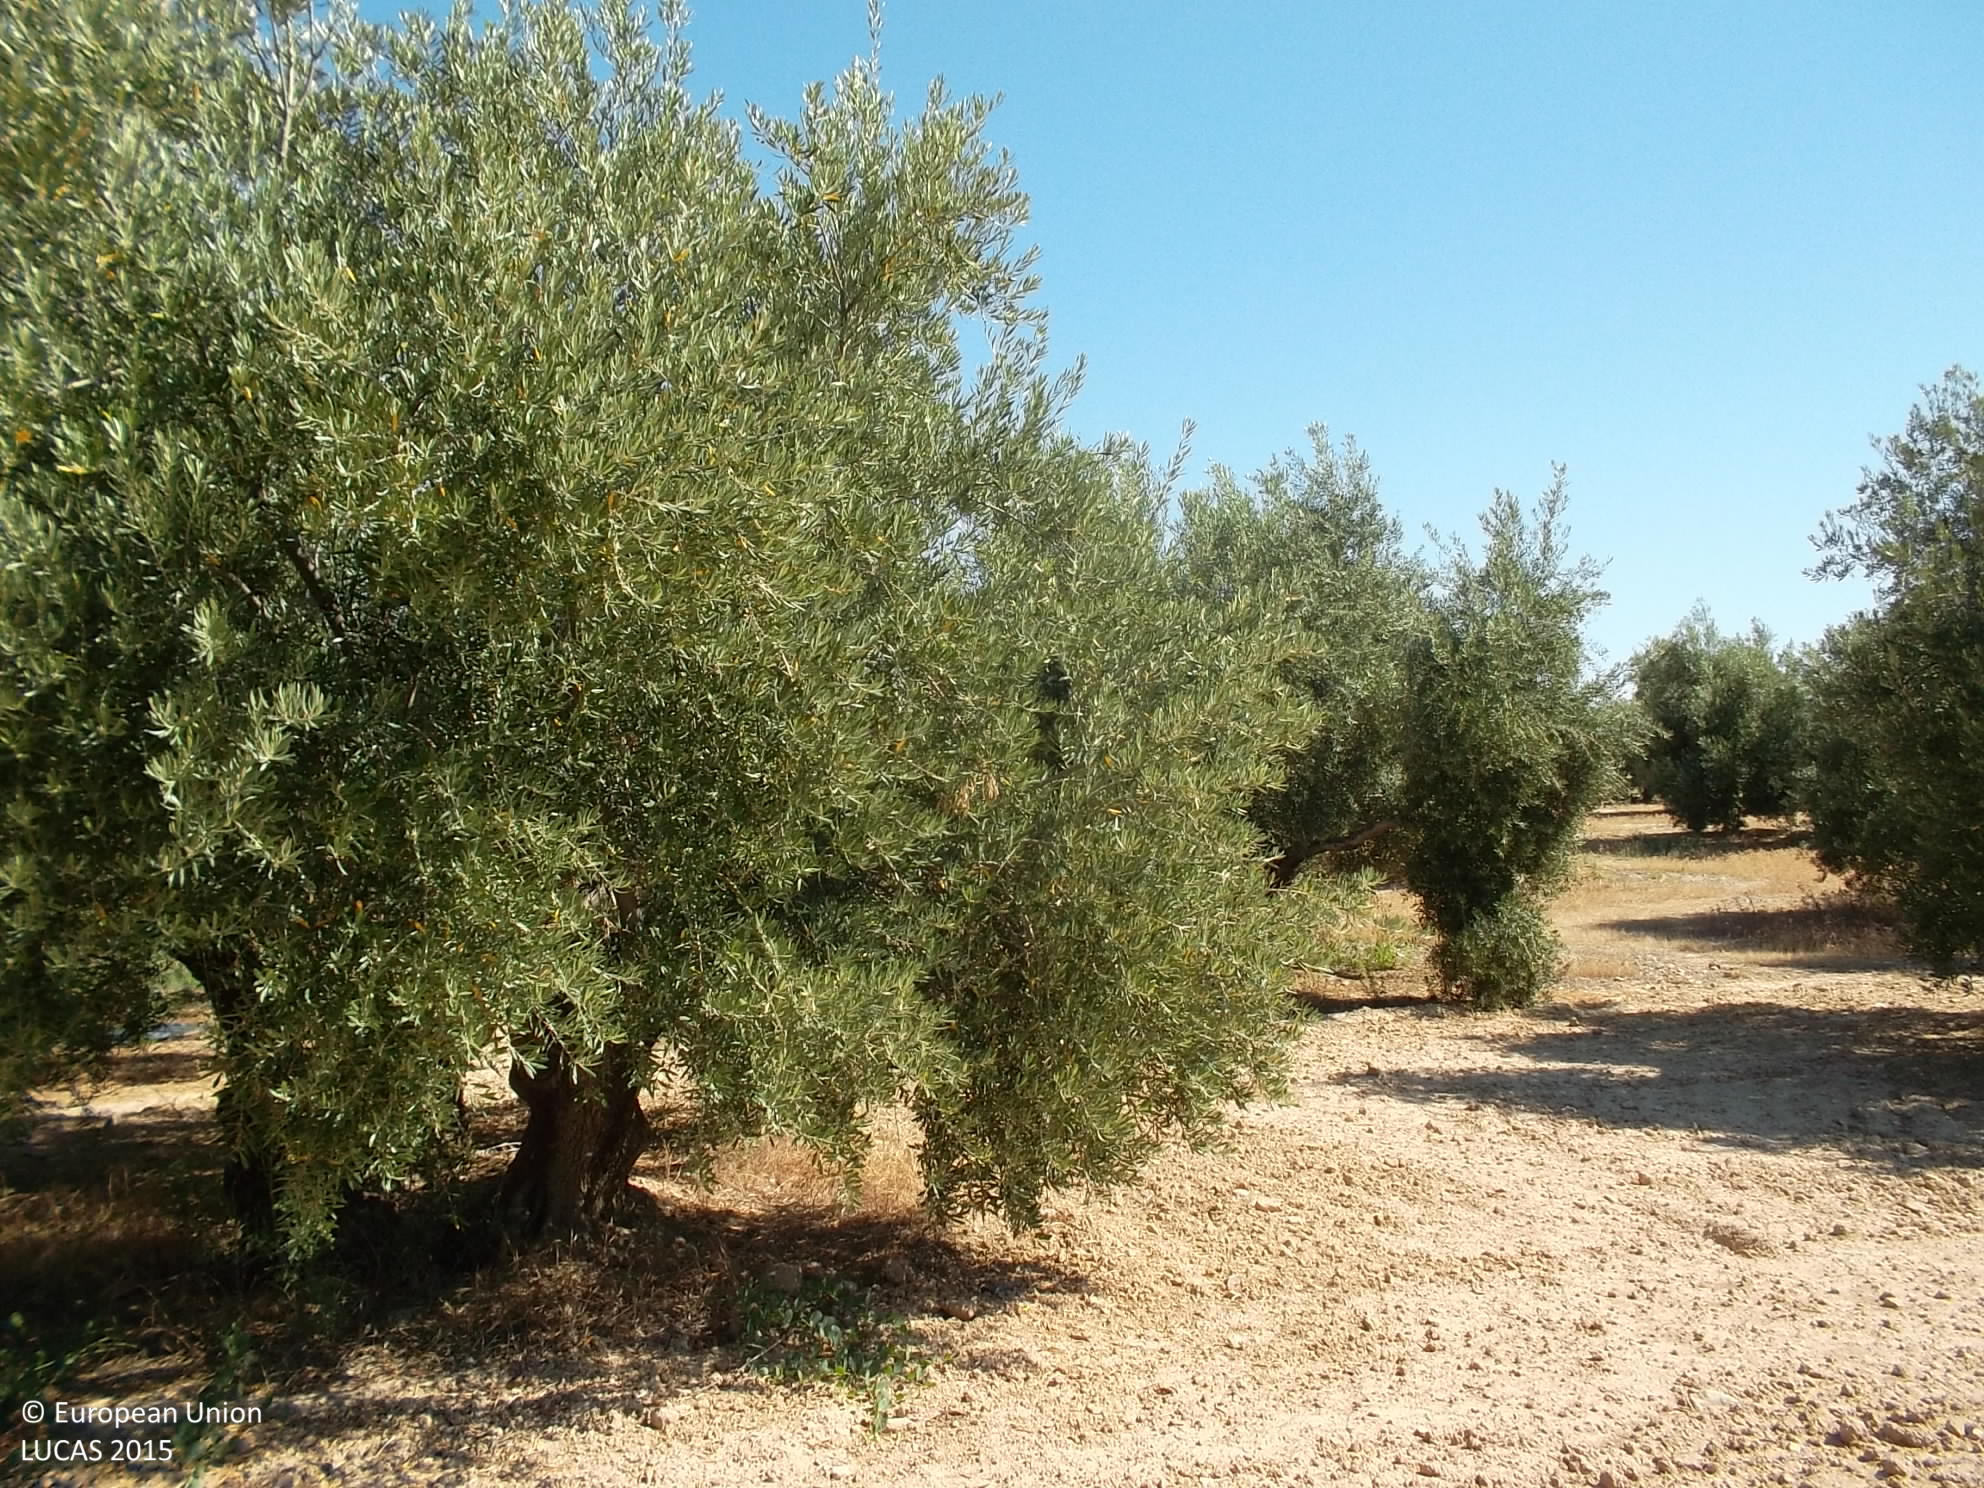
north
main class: Cropland
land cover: Olive groves
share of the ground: 25 - 50 %
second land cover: Other bare soil
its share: > 75 %
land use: Agriculture (excluding fallow land and kitchen gardens)
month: June
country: ES
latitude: 37.8507
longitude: -3.3283
